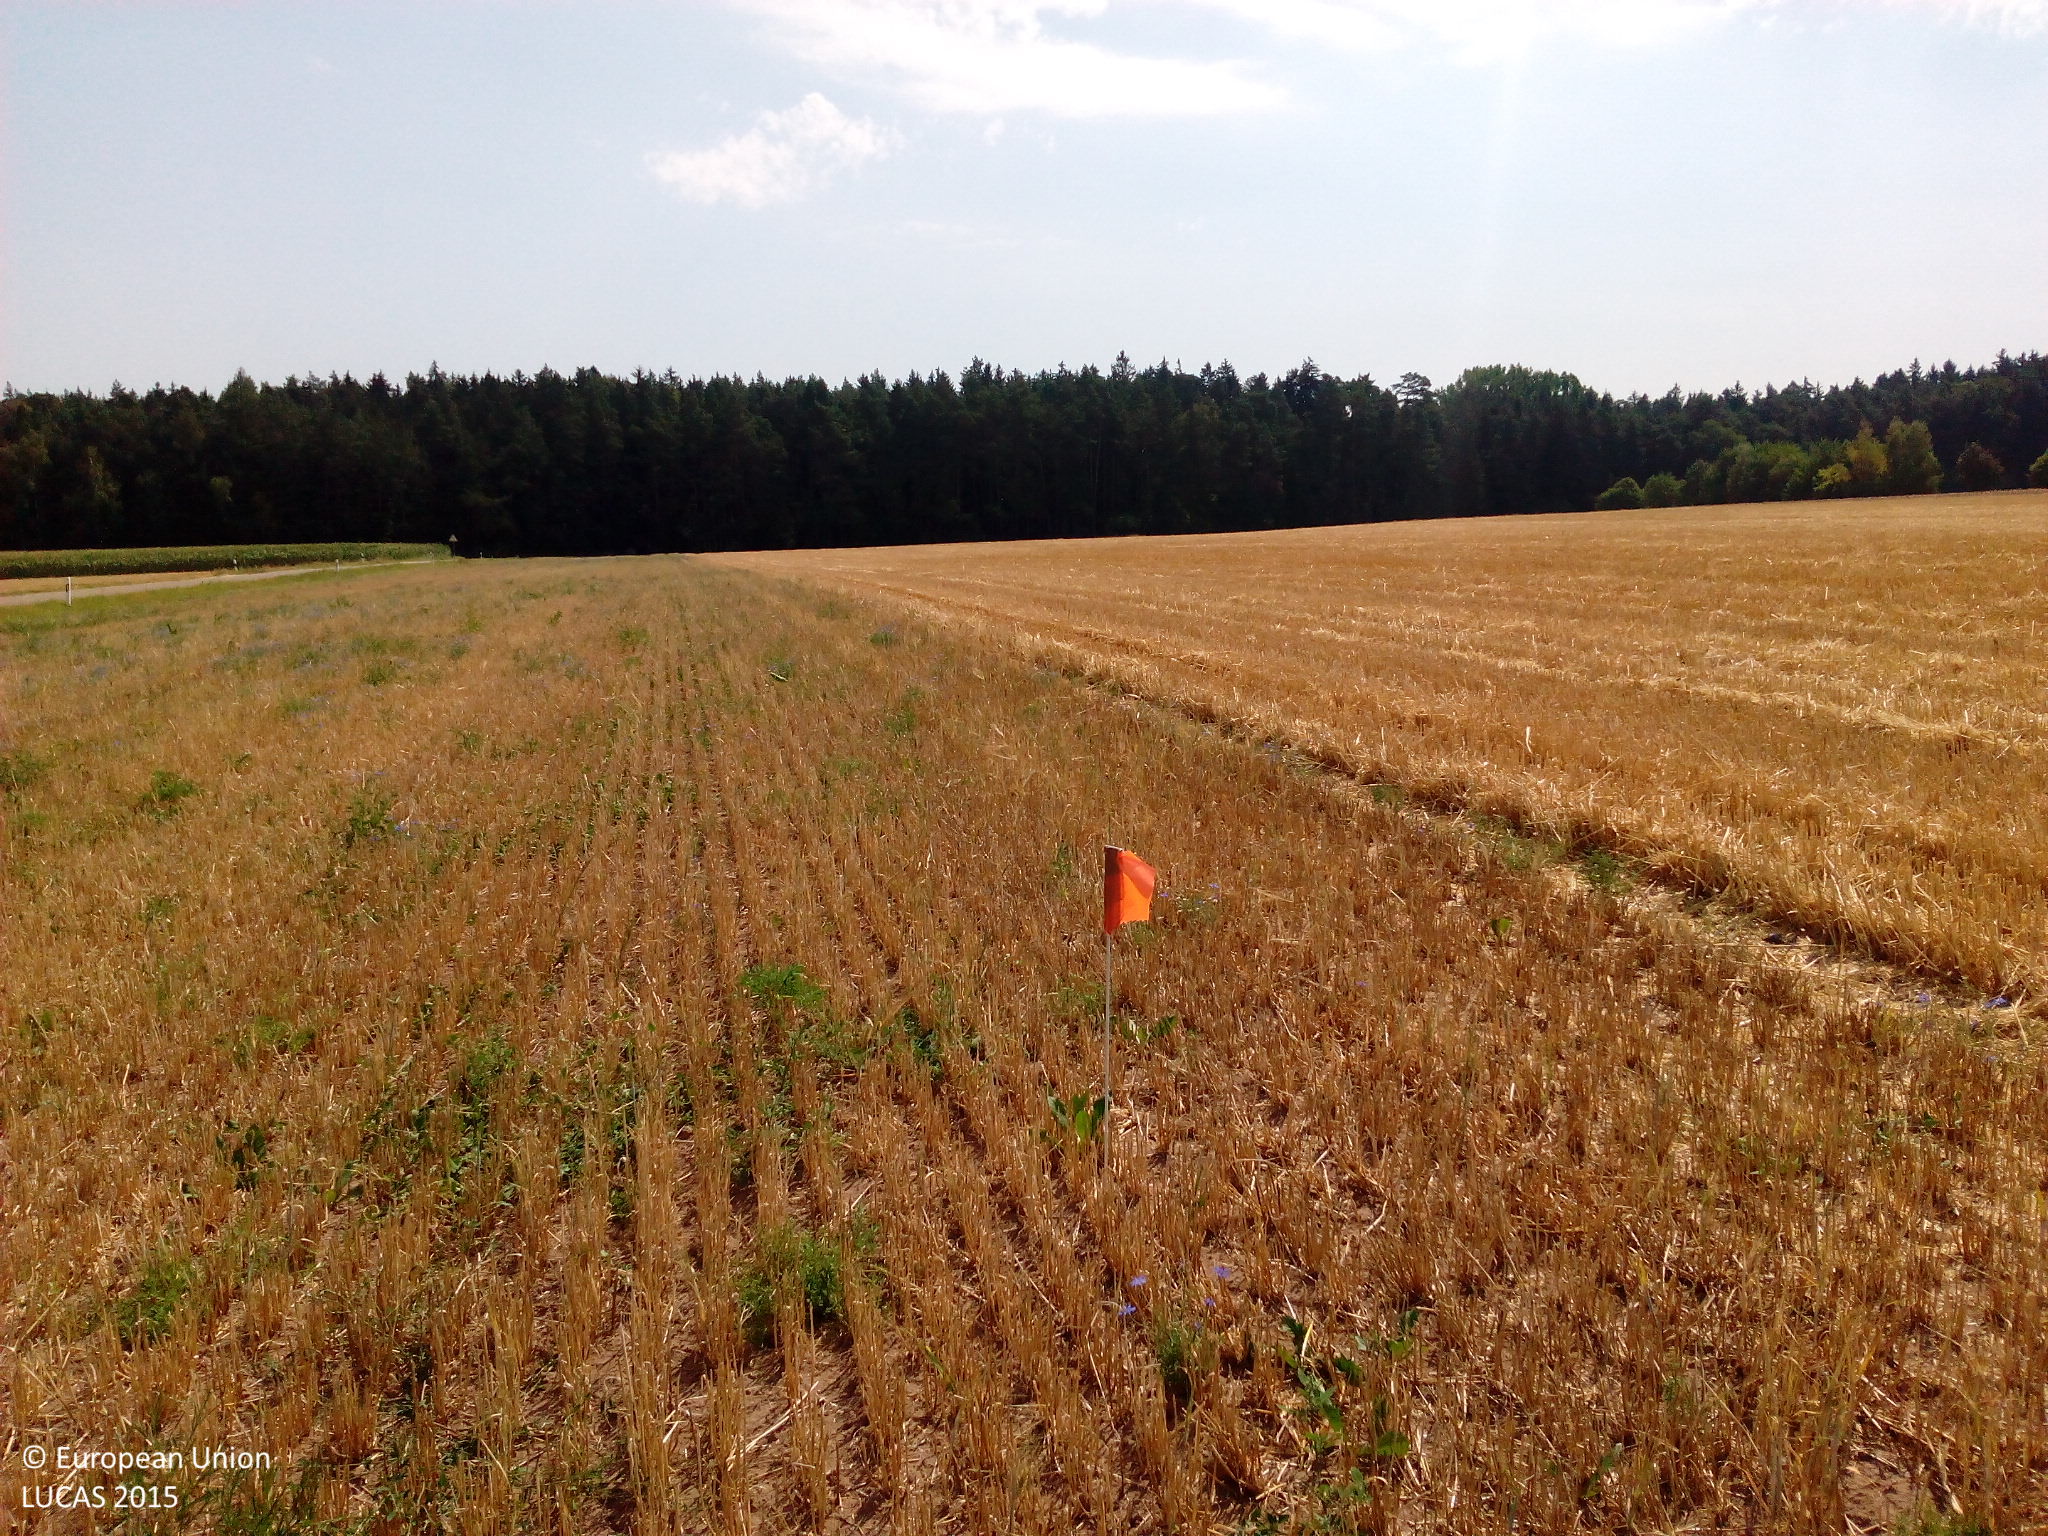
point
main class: Cropland
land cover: Barley
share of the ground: < 10 %
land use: Agriculture (excluding fallow land and kitchen gardens)
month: August
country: DE
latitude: 49.1048
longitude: 10.2601
